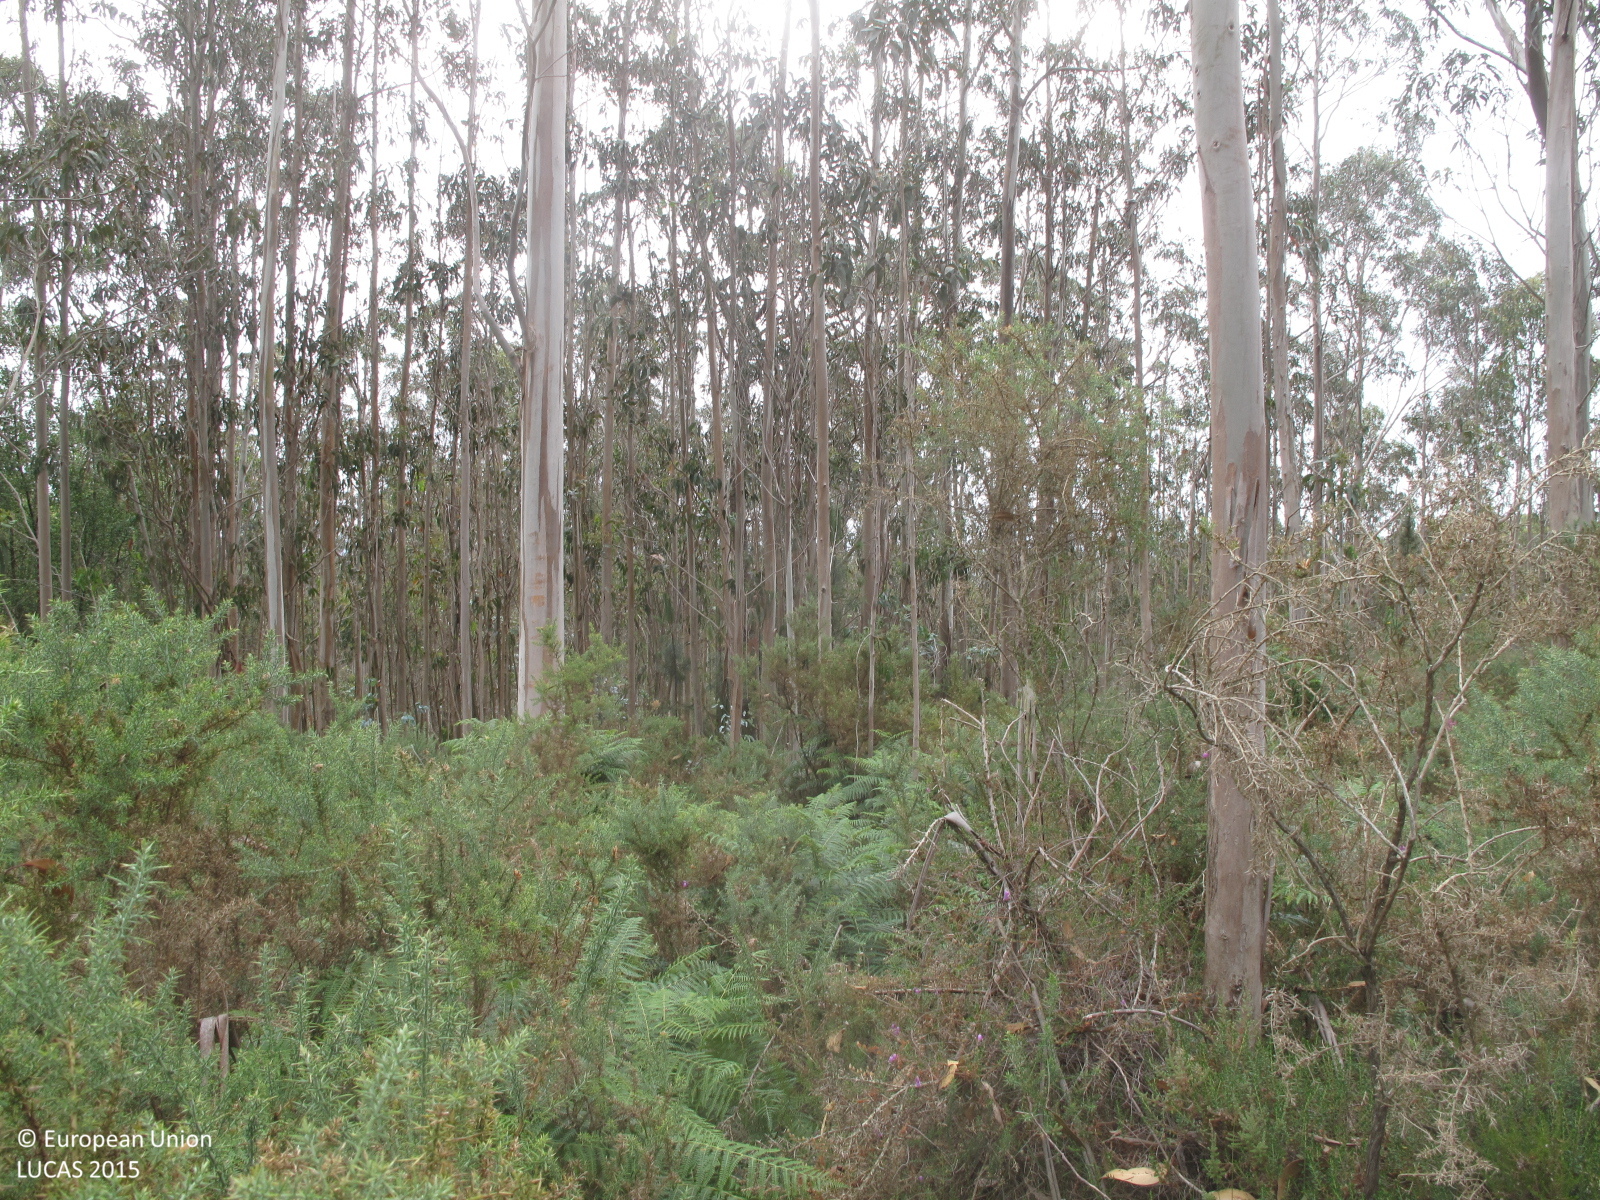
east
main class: Woodland
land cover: Broadleaved woodland
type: exotic forest
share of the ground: 25 - 50 %
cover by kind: shrubs 60 %, broadleaved forest trees 30 %, herbaceous plants 10 %
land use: Forestry
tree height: > 5 m
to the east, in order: Broadleaved woodland; Tracks; Broadleaved woodland
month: July
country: ES
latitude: 43.5873
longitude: -8.1215
